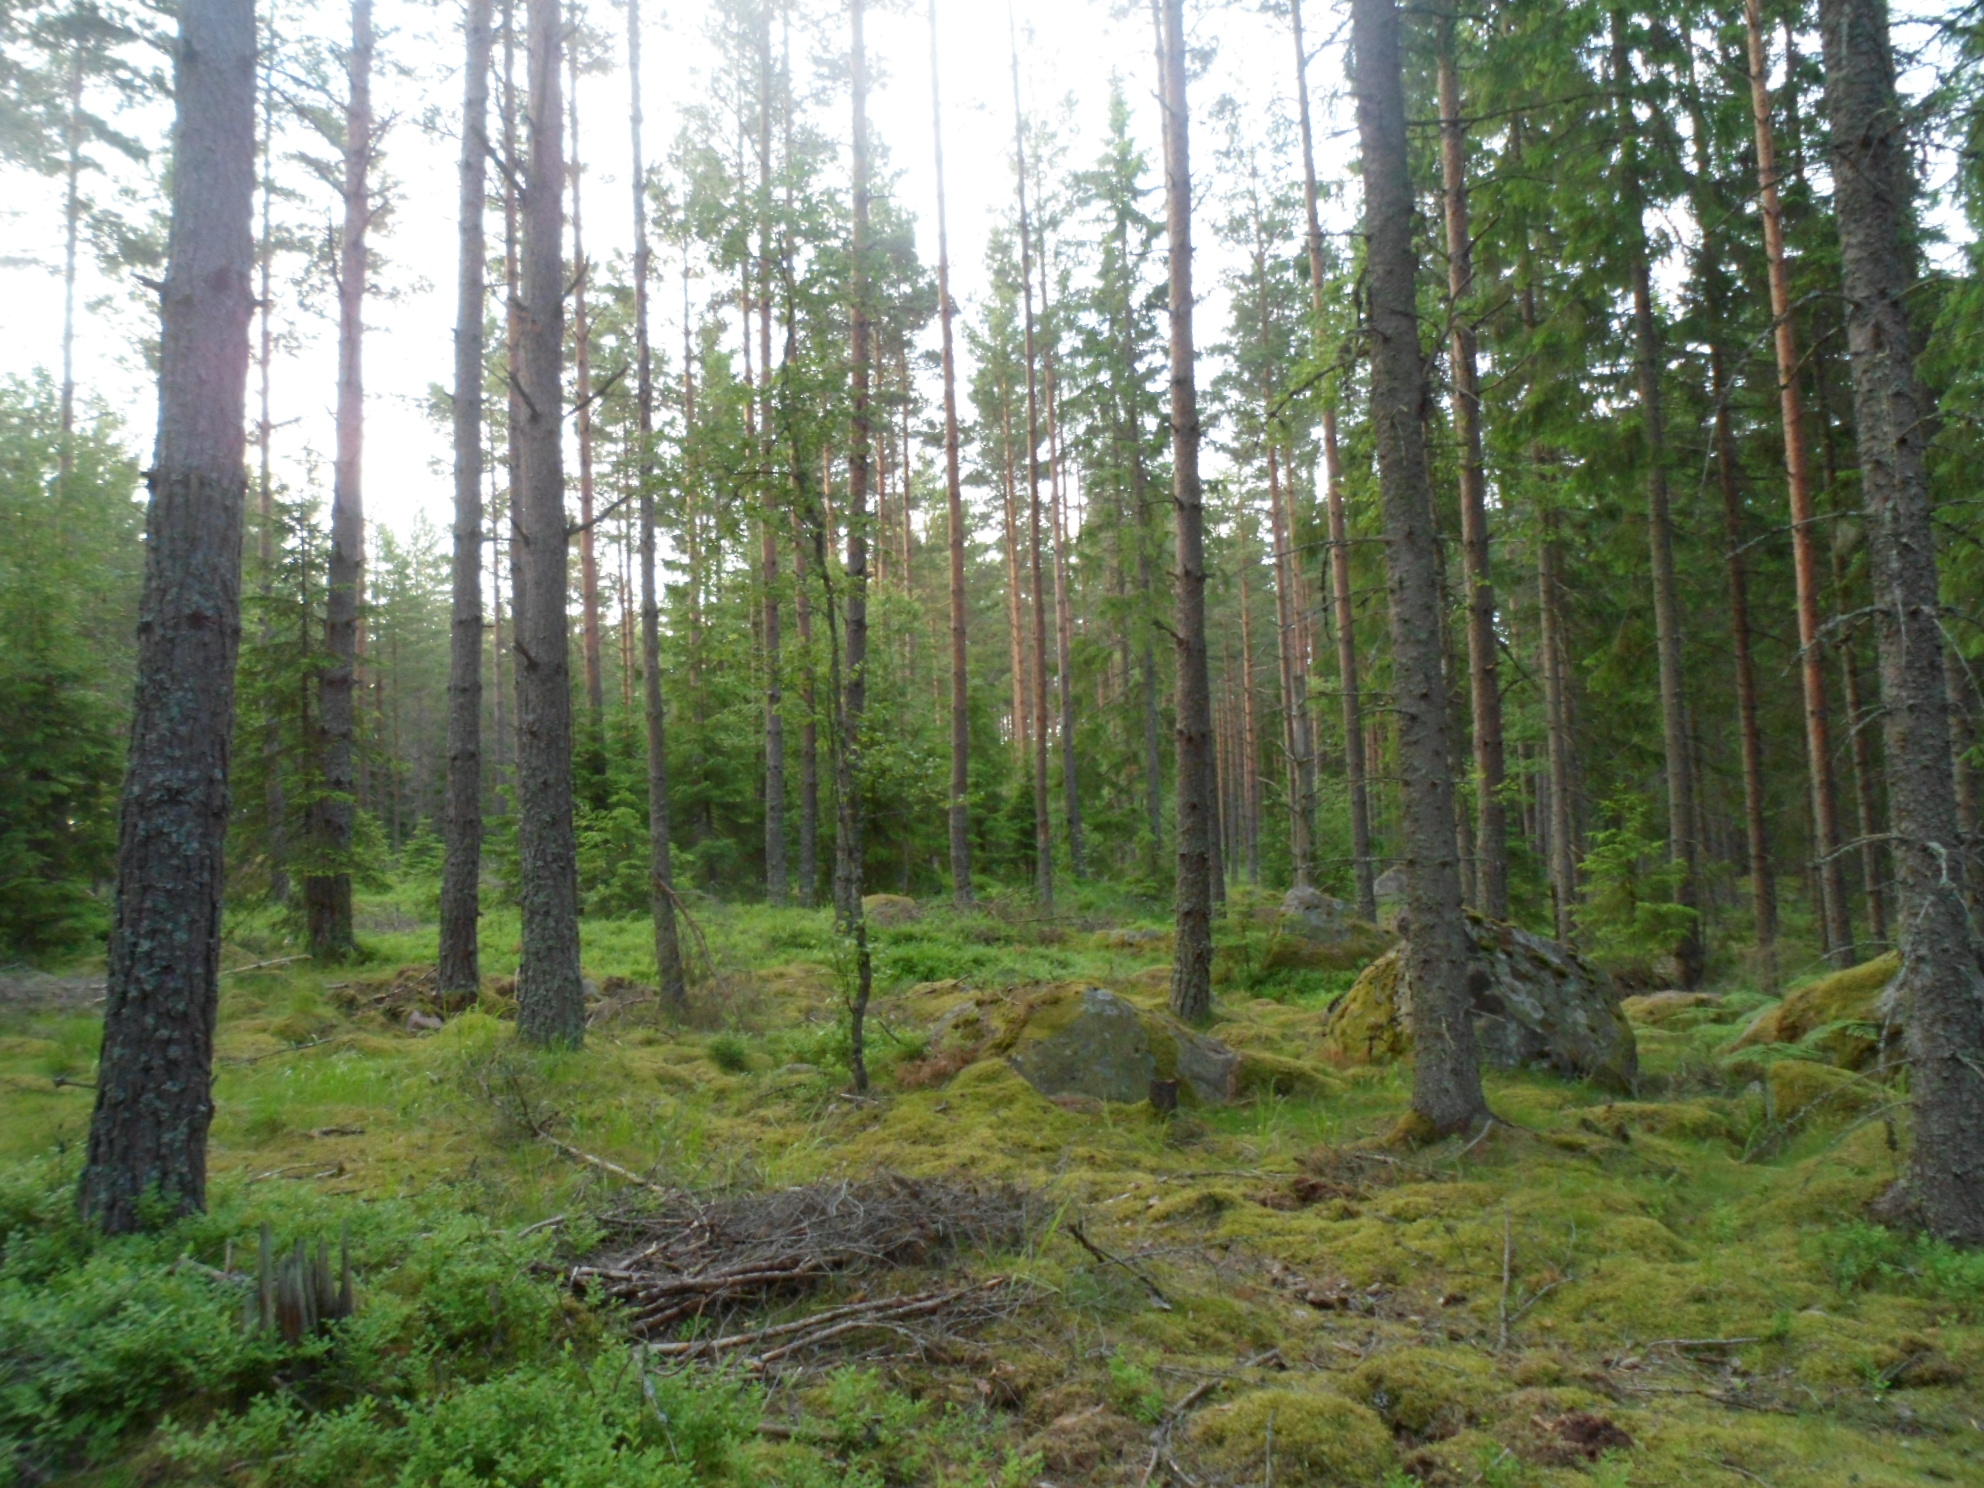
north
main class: Woodland
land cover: Pine dominated coniferous woodland
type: boreal forest
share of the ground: 50 - 75 %
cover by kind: coniferous forest trees 55 %, lichens and mosses 25 %, shrubs 20 %
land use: Forestry
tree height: > 5 m
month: June
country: SE
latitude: 57.0590
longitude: 15.5546
